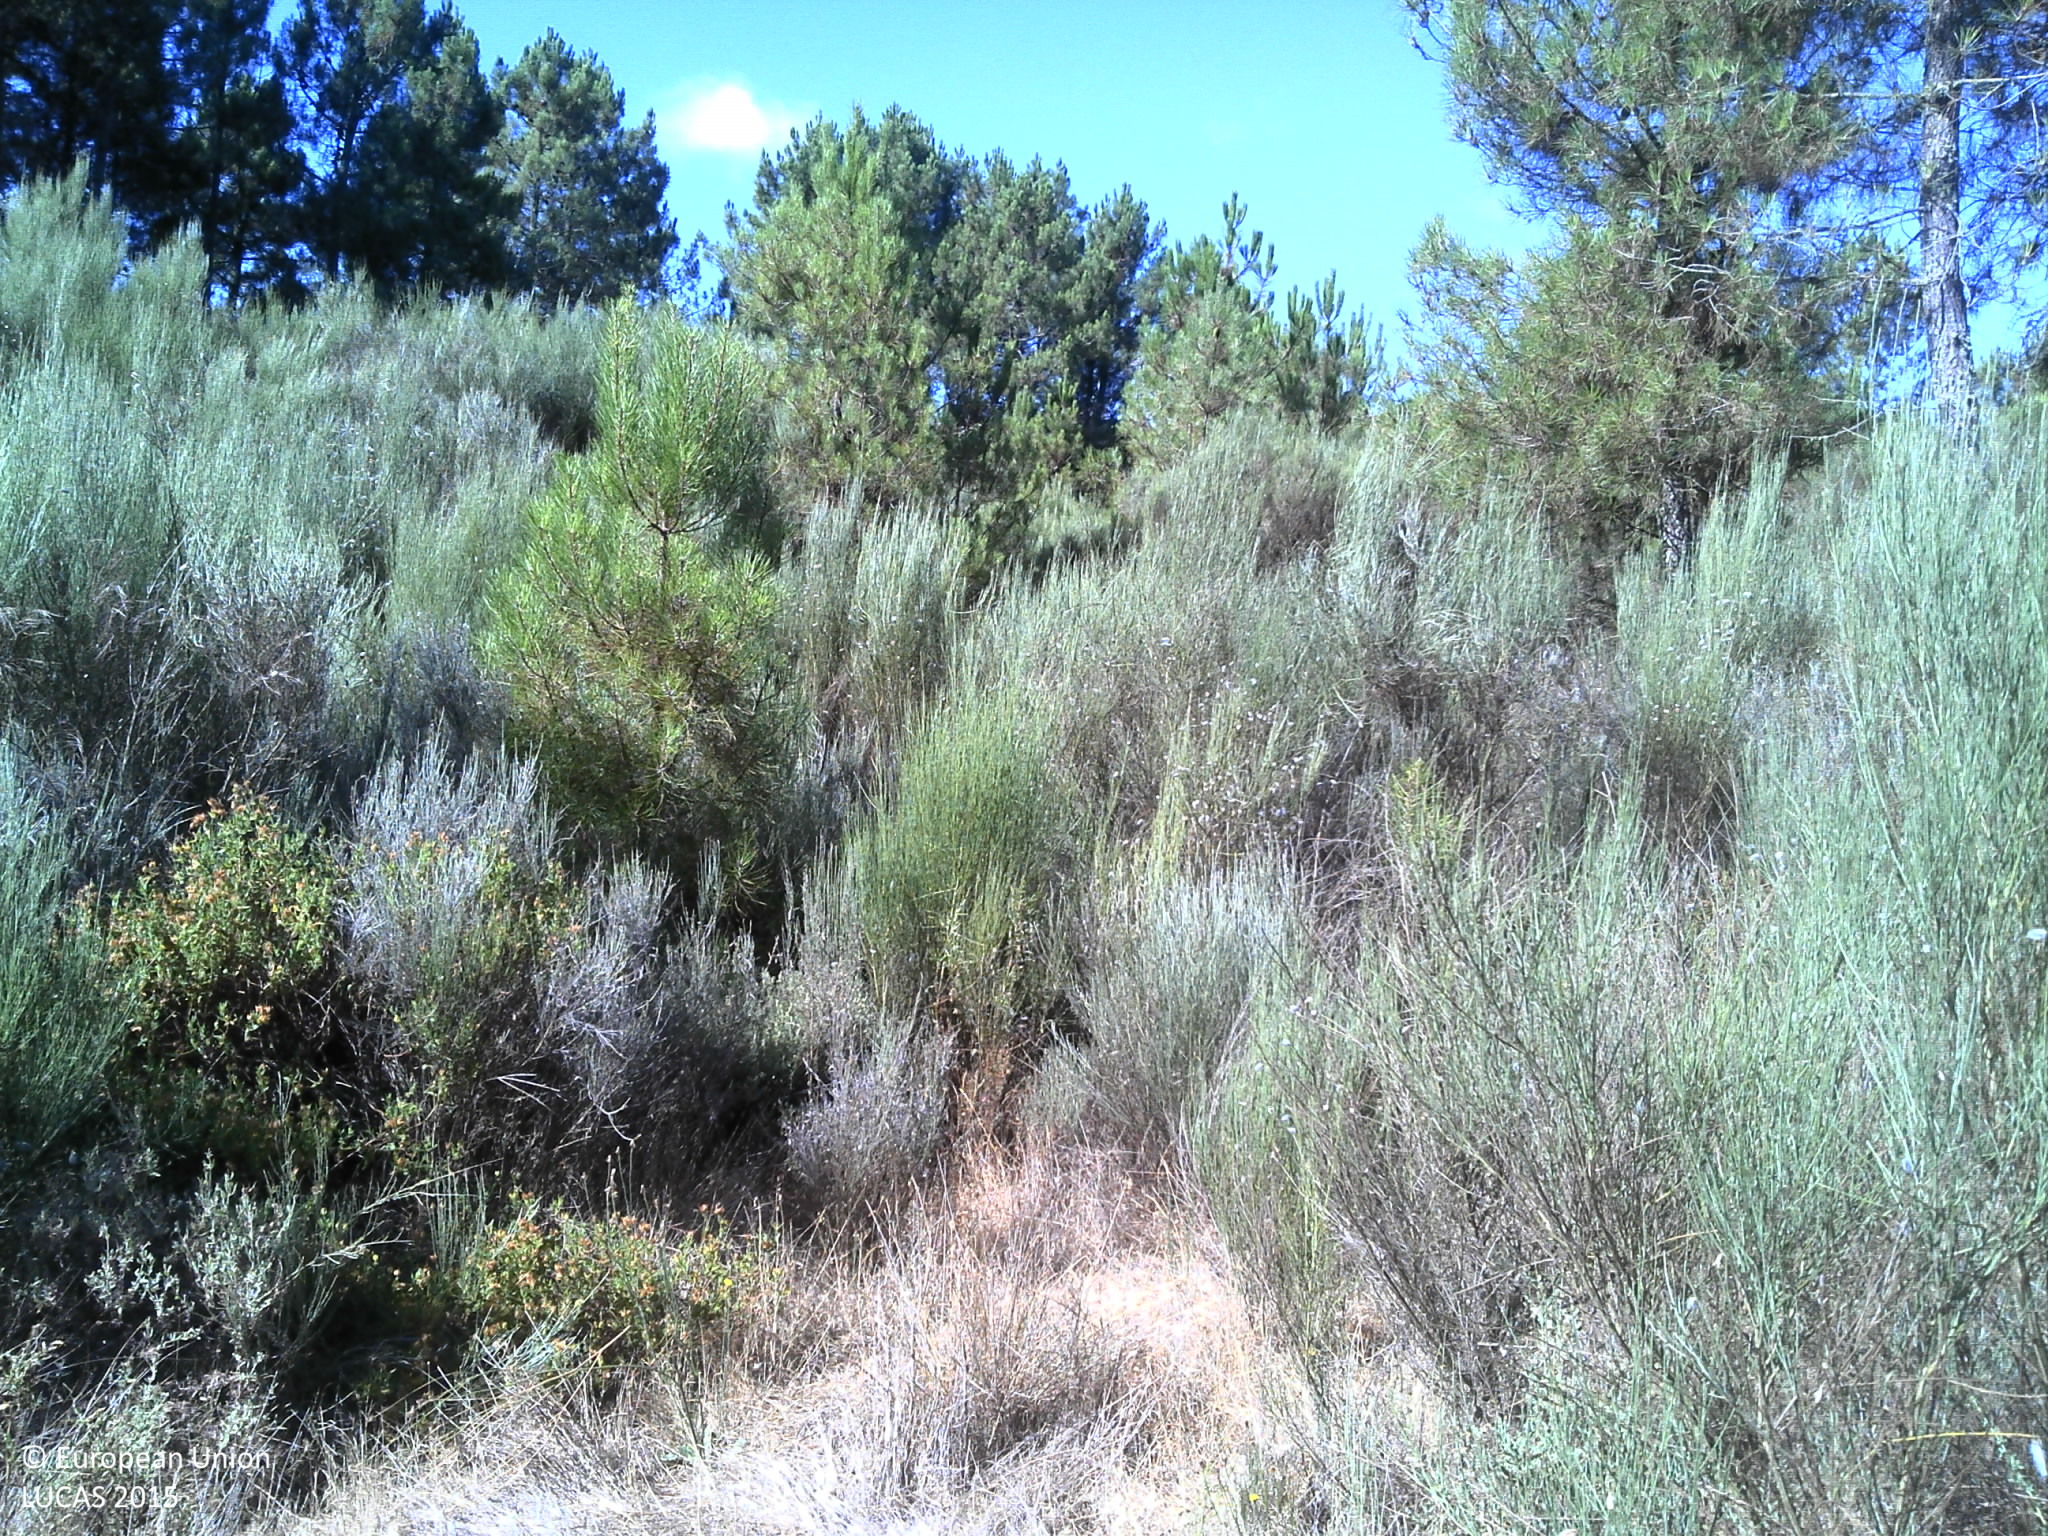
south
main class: Shrubland
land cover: Shrubland without tree cover
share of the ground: > 75 %
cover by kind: shrubs 100 %
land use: Semi-natural and natural areas not in use
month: July
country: PT
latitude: 41.3048
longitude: -7.4777
